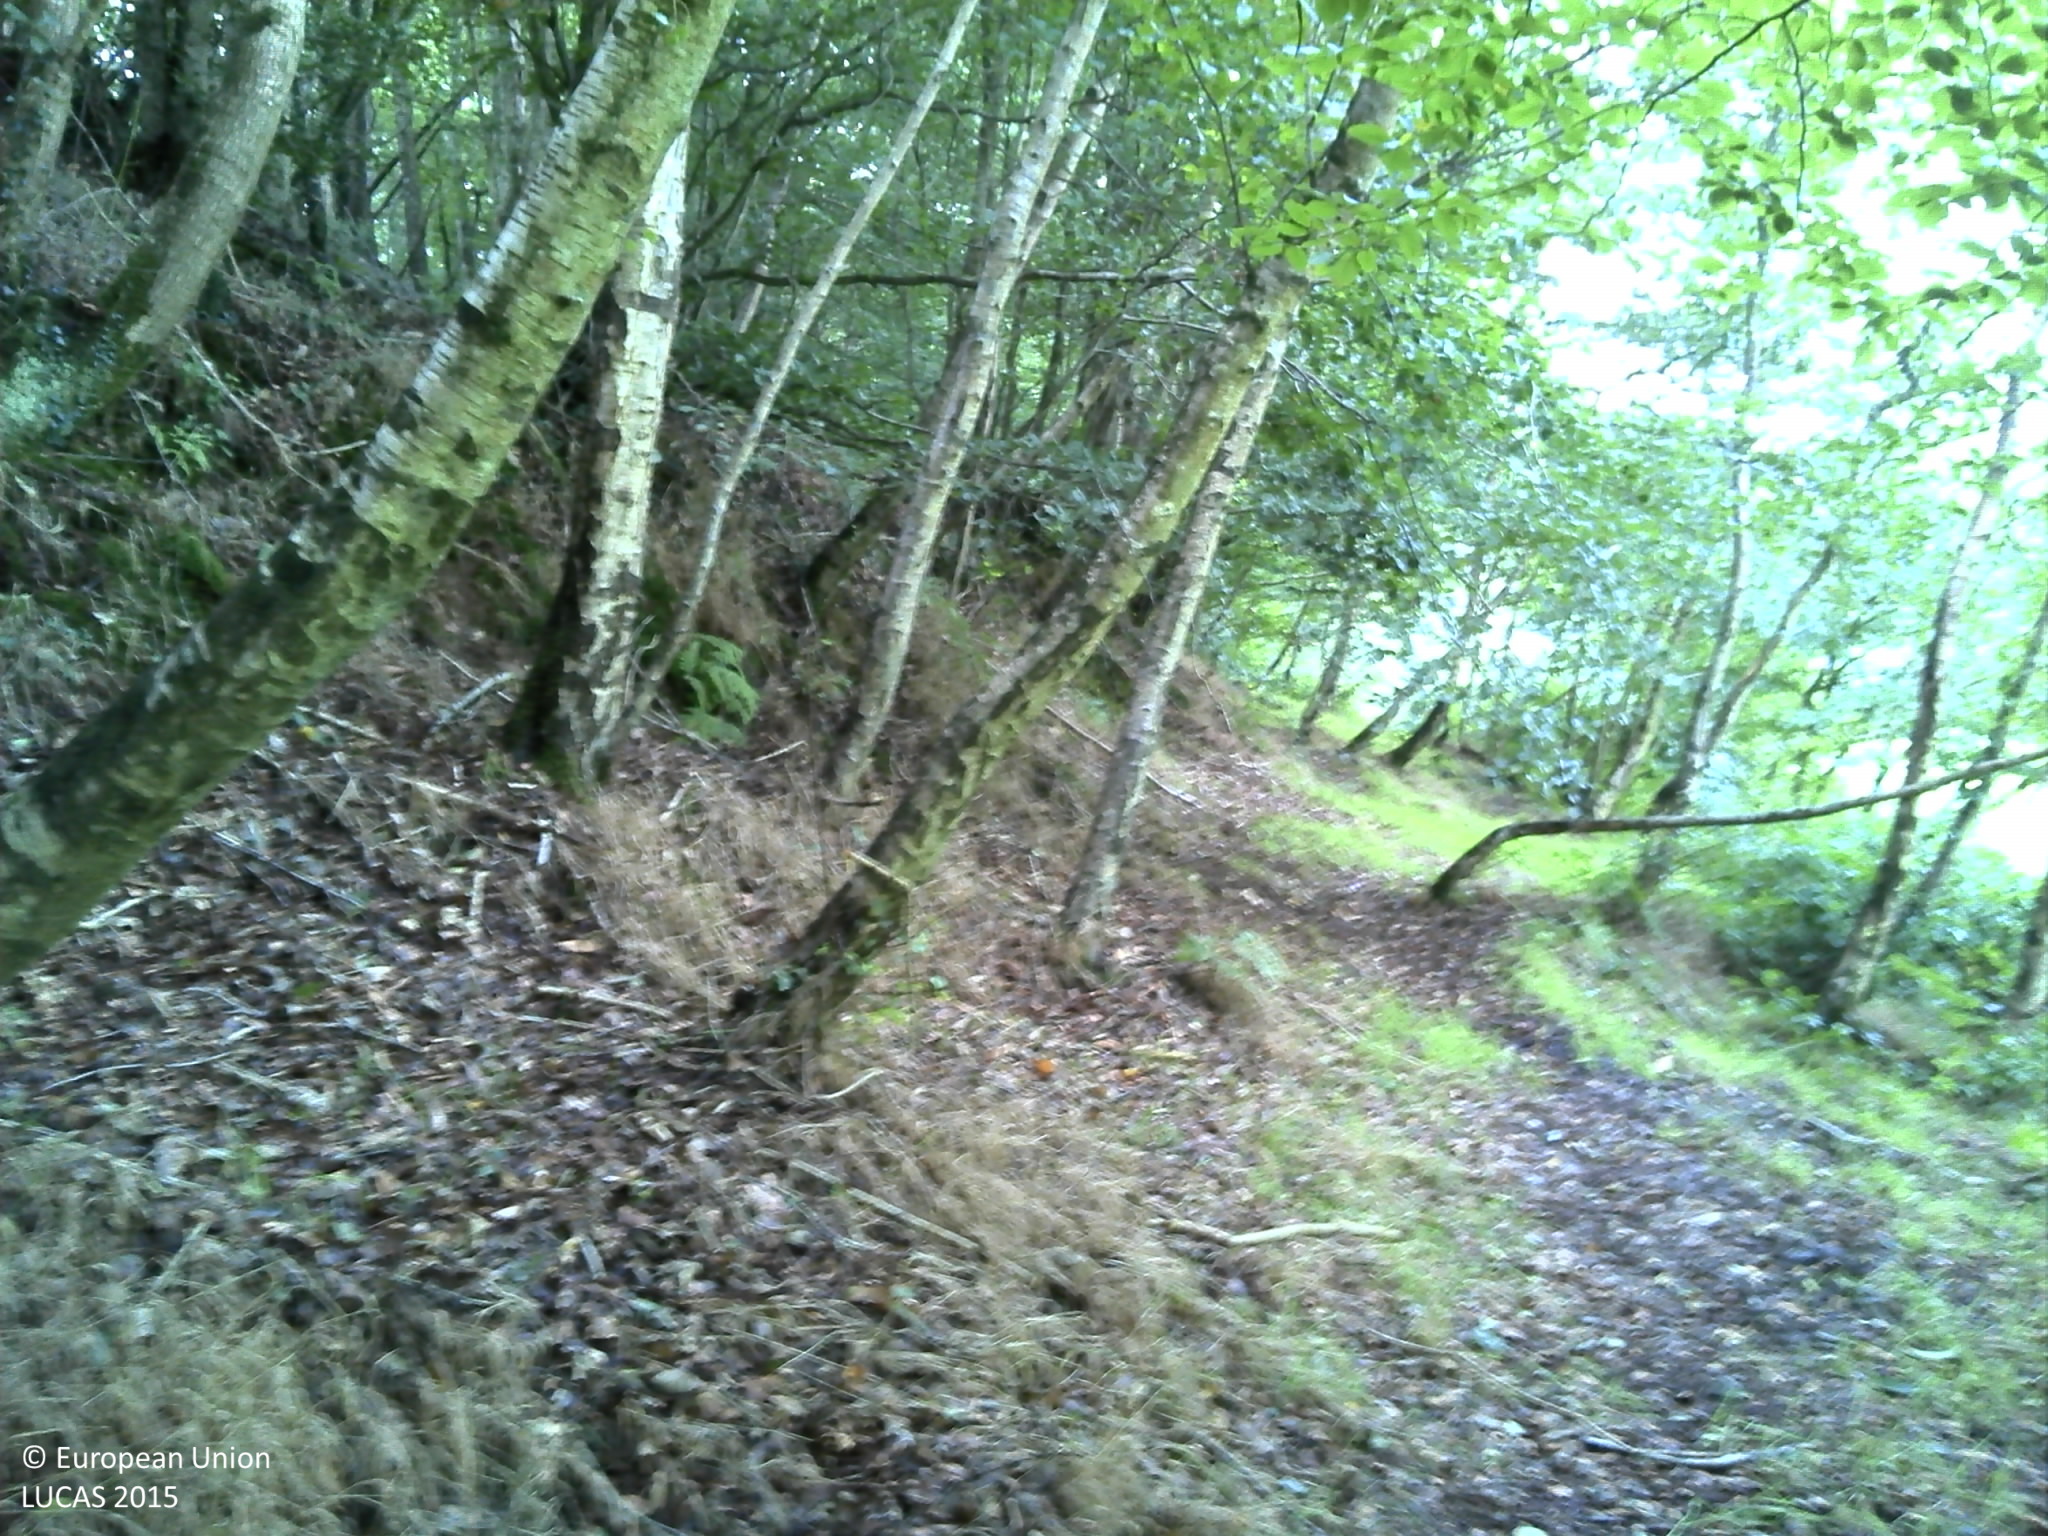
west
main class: Woodland
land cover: Broadleaved woodland
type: beech forest
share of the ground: > 75 %
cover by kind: broadleaved forest trees 100 %
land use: Forestry
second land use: Agriculture (excluding fallow land and kitchen gardens)
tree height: > 5 m
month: August
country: FR
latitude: 48.5698
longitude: -4.2564
